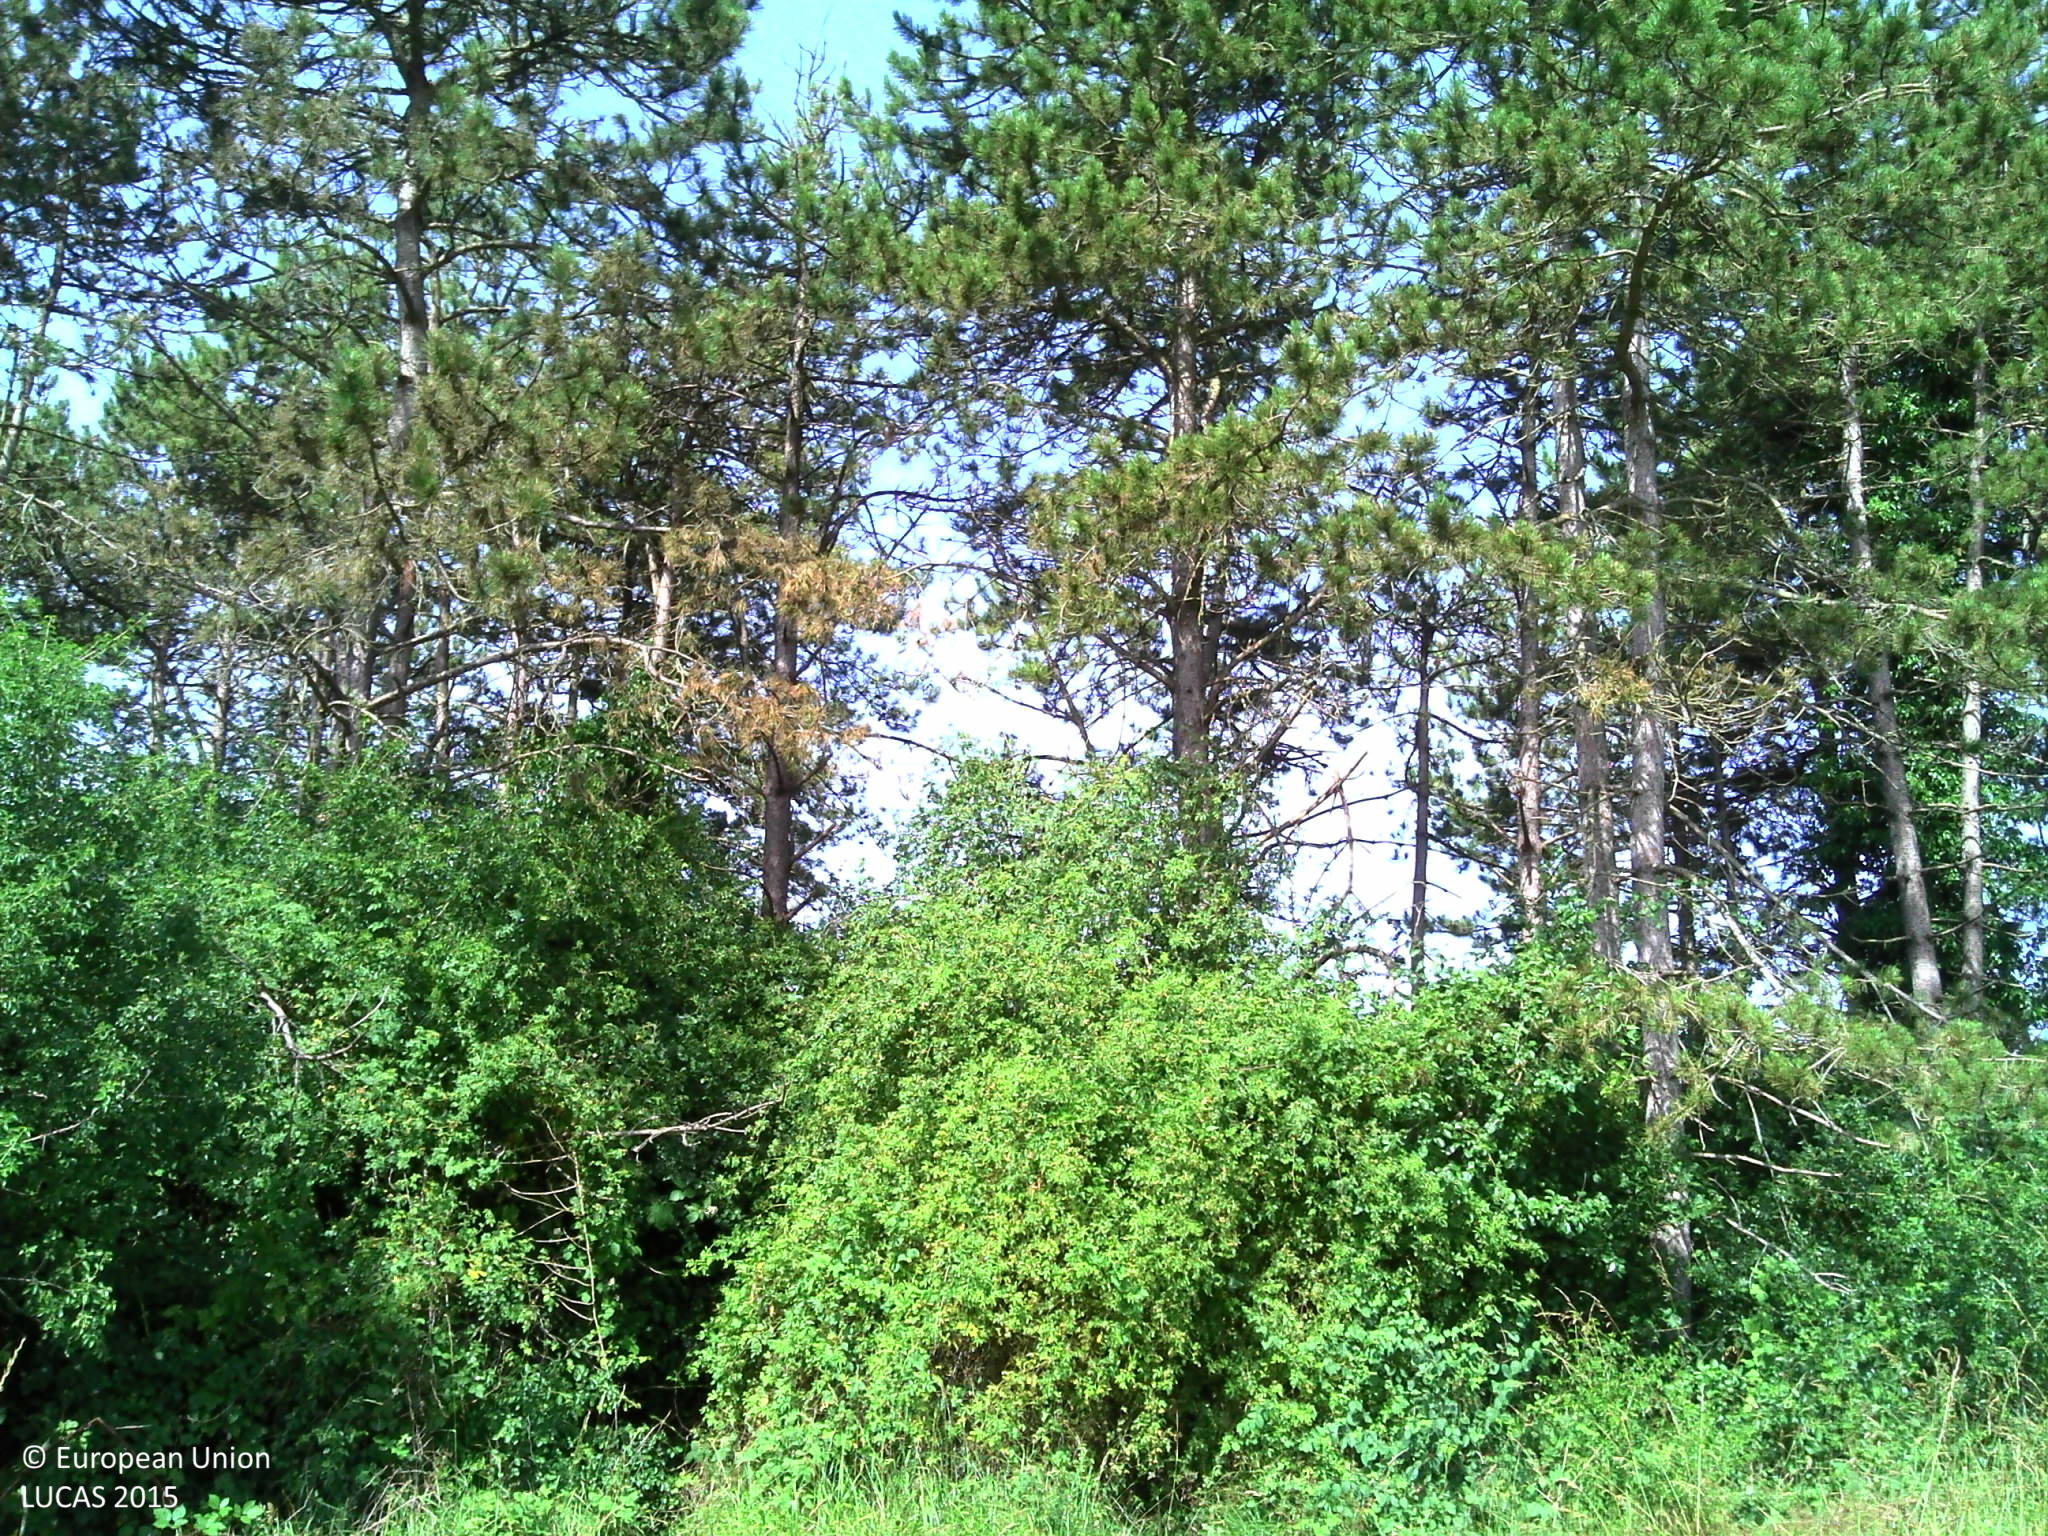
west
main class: Woodland
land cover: Pine dominated mixed woodland
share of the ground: 25 - 50 %
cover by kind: coniferous forest trees 50 %, broadleaved forest trees 30 %, shrubs 10 %, herbaceous plants 10 %
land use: Semi-natural and natural areas not in use
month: June
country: FR
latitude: 47.4350
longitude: 3.4862
